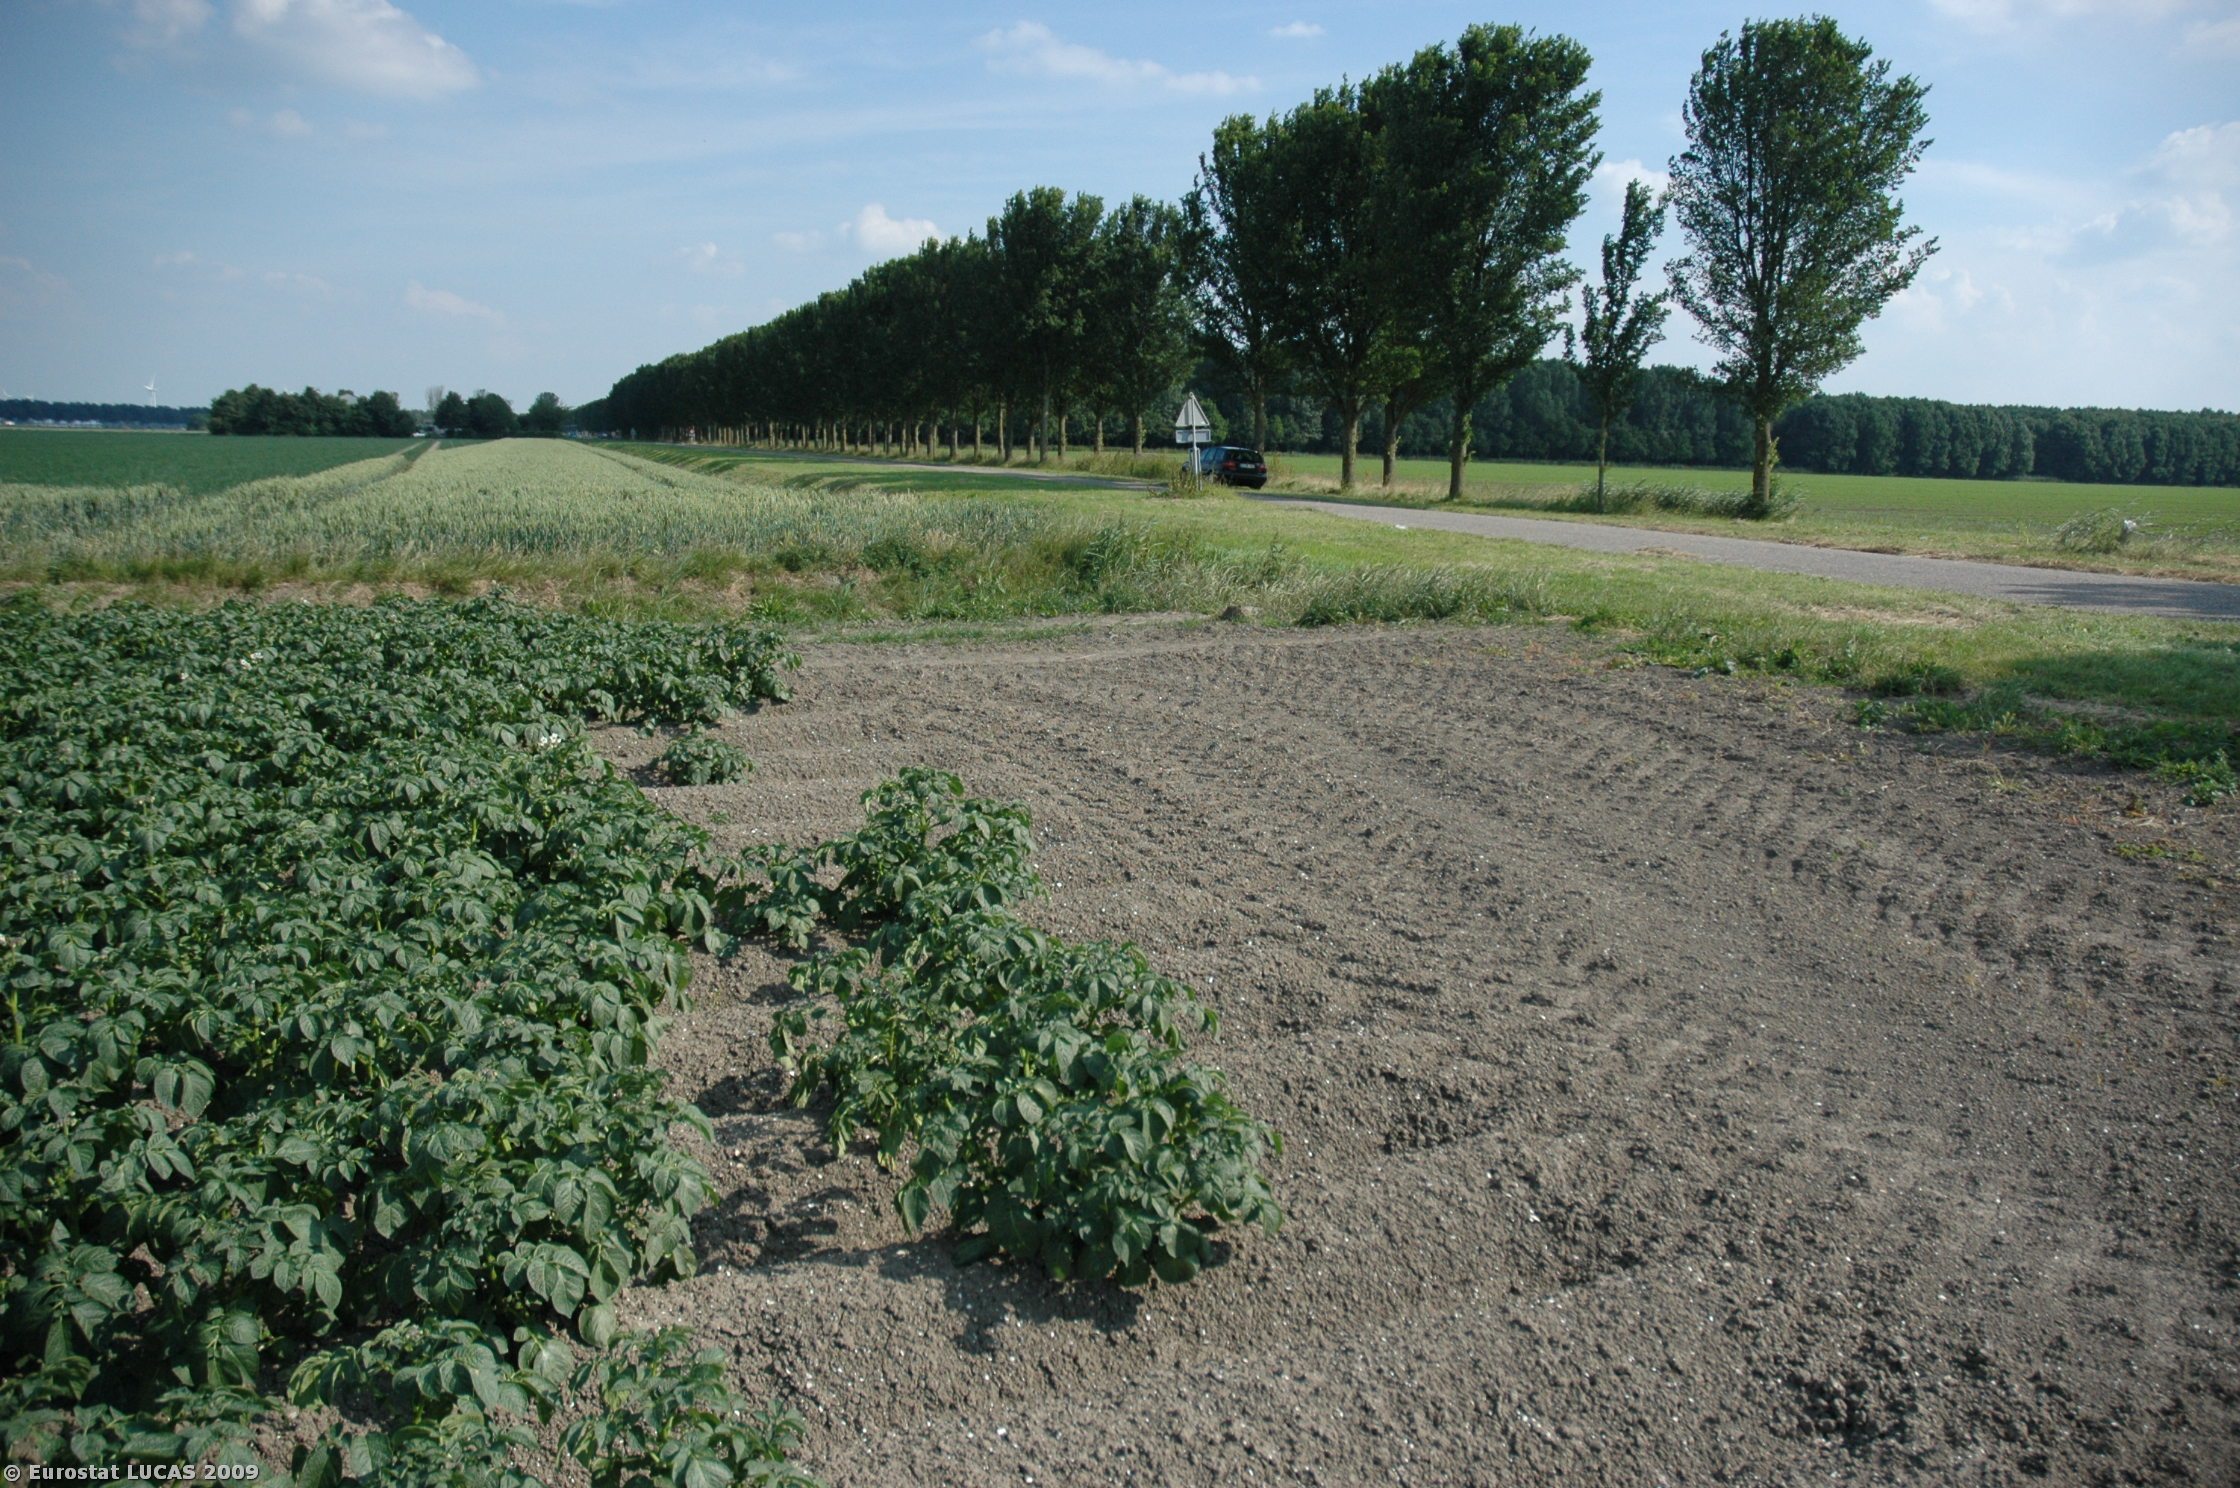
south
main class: Cropland
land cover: Potatoes
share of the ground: > 75 %
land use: Agriculture (excluding fallow land and kitchen gardens)
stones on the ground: < 10 %
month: June
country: NL
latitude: 52.3570
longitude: 5.3141
